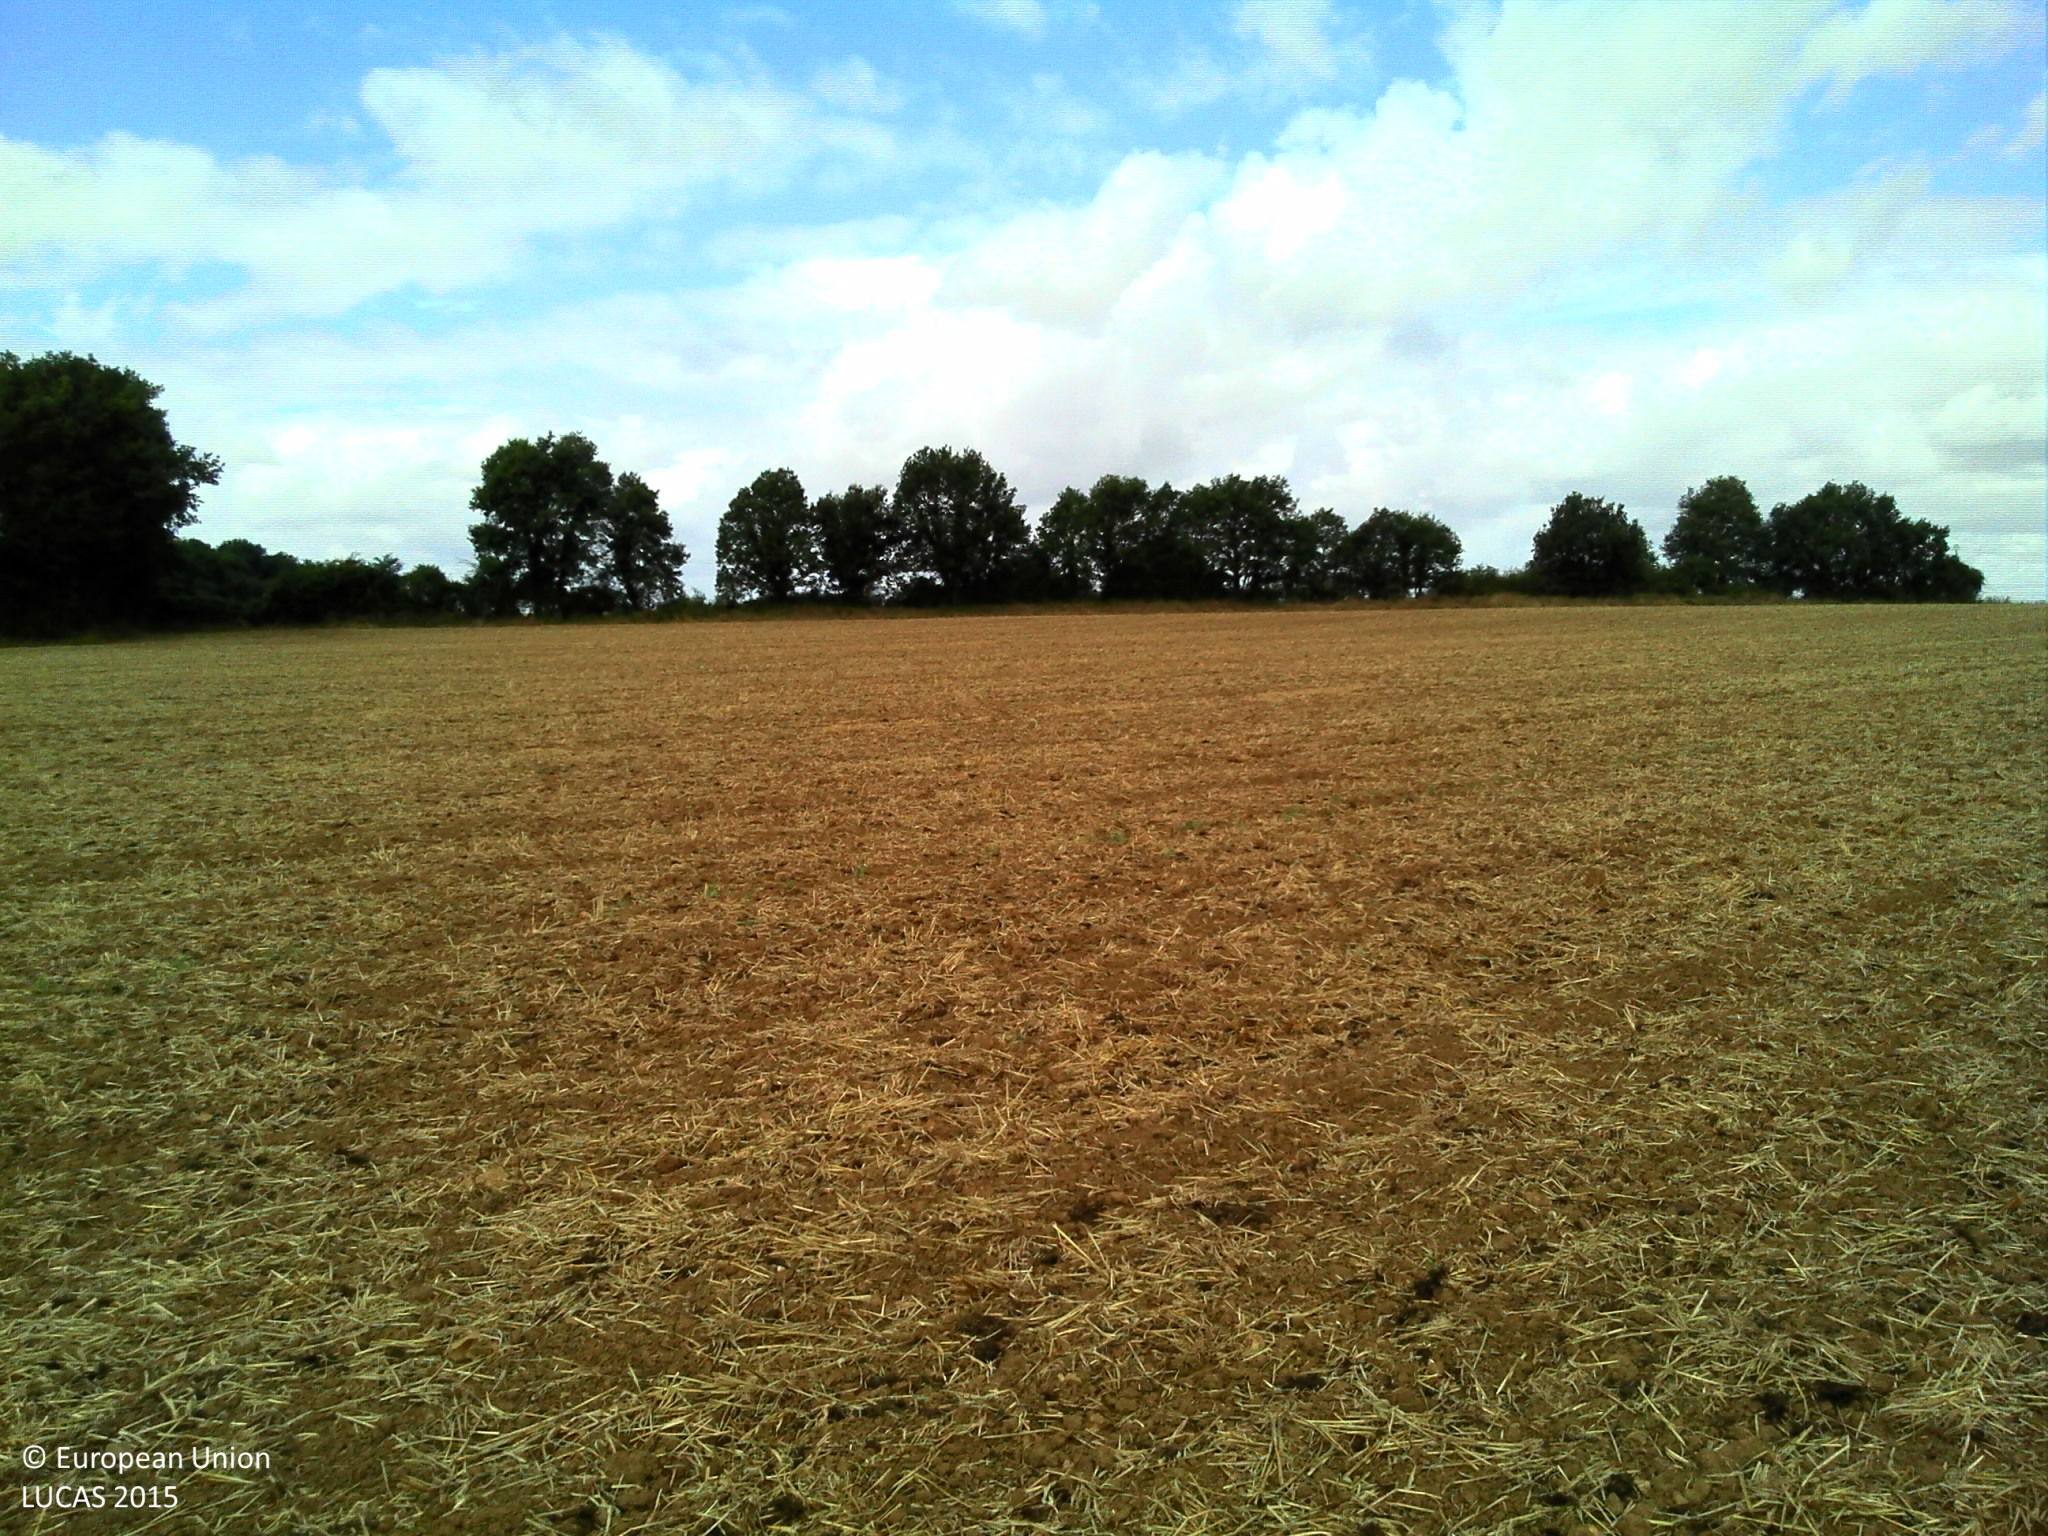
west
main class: Cropland
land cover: Barley
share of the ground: < 10 %
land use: Agriculture (excluding fallow land and kitchen gardens)
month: July
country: FR
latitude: 46.3912
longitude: 0.2144
